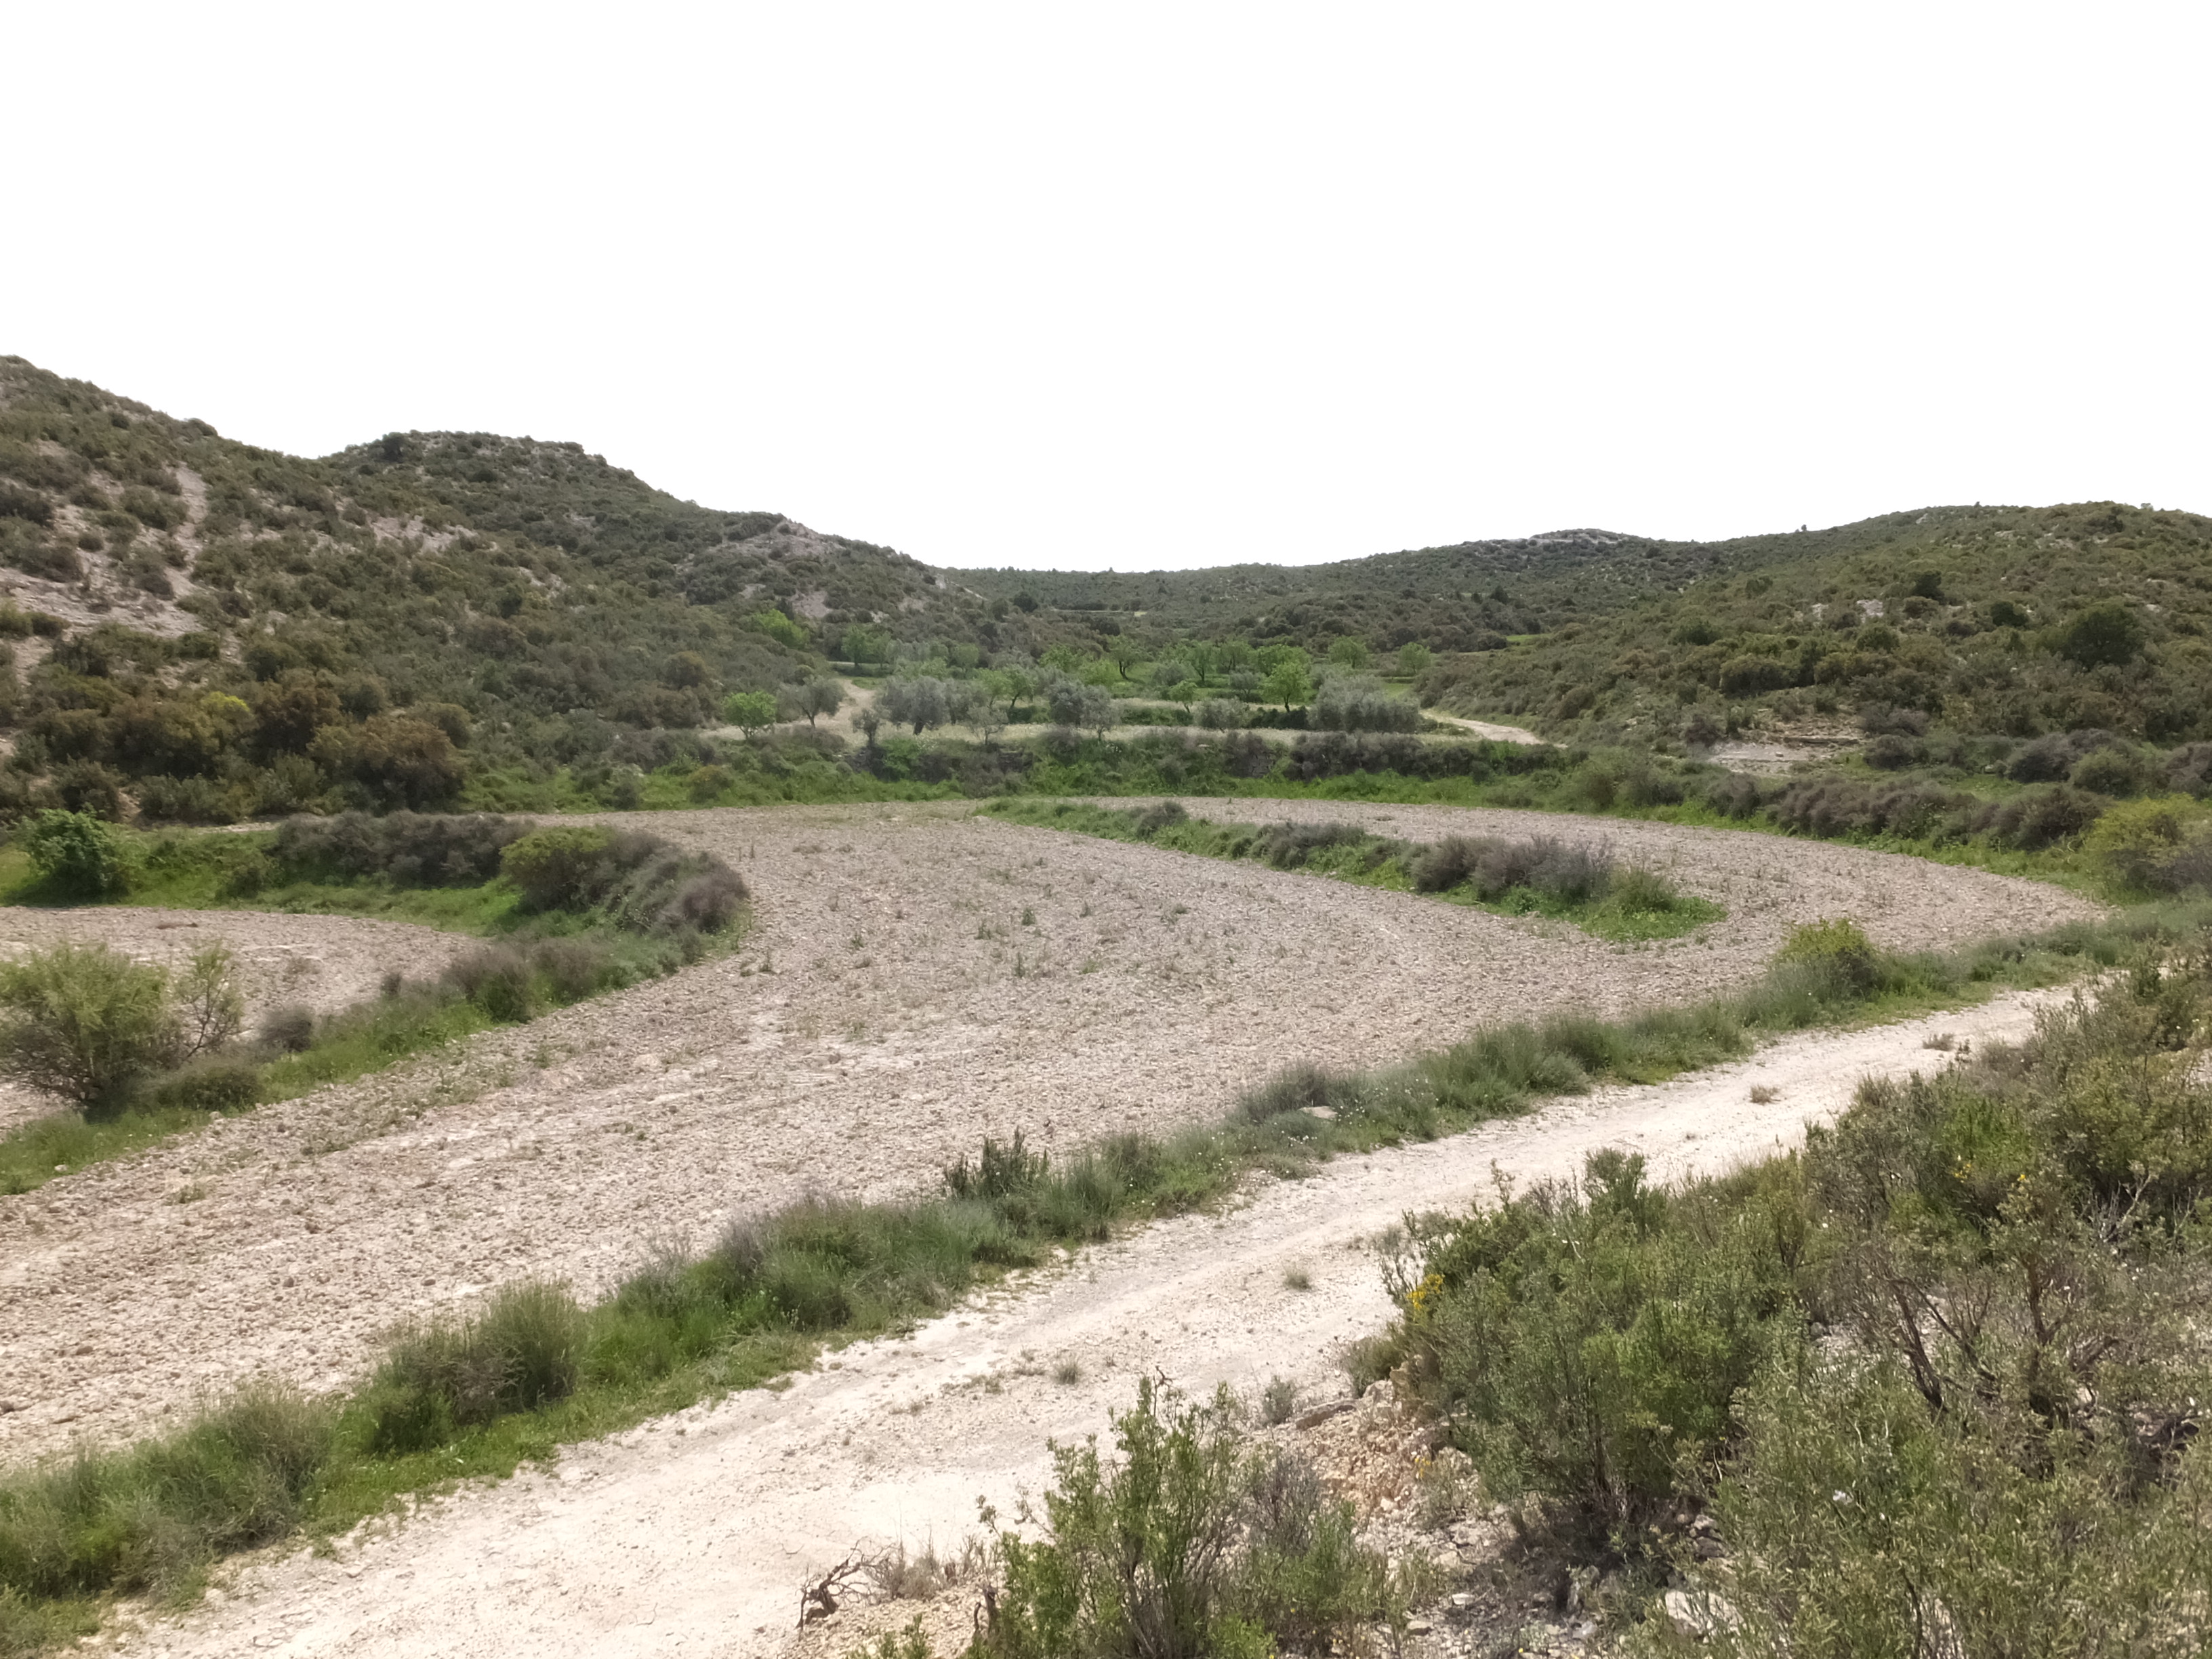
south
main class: Shrubland
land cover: Shrubland with sparse tree cover
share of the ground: > 75 %
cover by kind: shrubs 50 %, unconsolidated bare surface 25 %, herbaceous plants 20 %, broadleaved forest trees 5 %
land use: Semi-natural and natural areas not in use
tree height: < 5 m
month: April
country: ES
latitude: 41.5869
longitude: -0.2490
